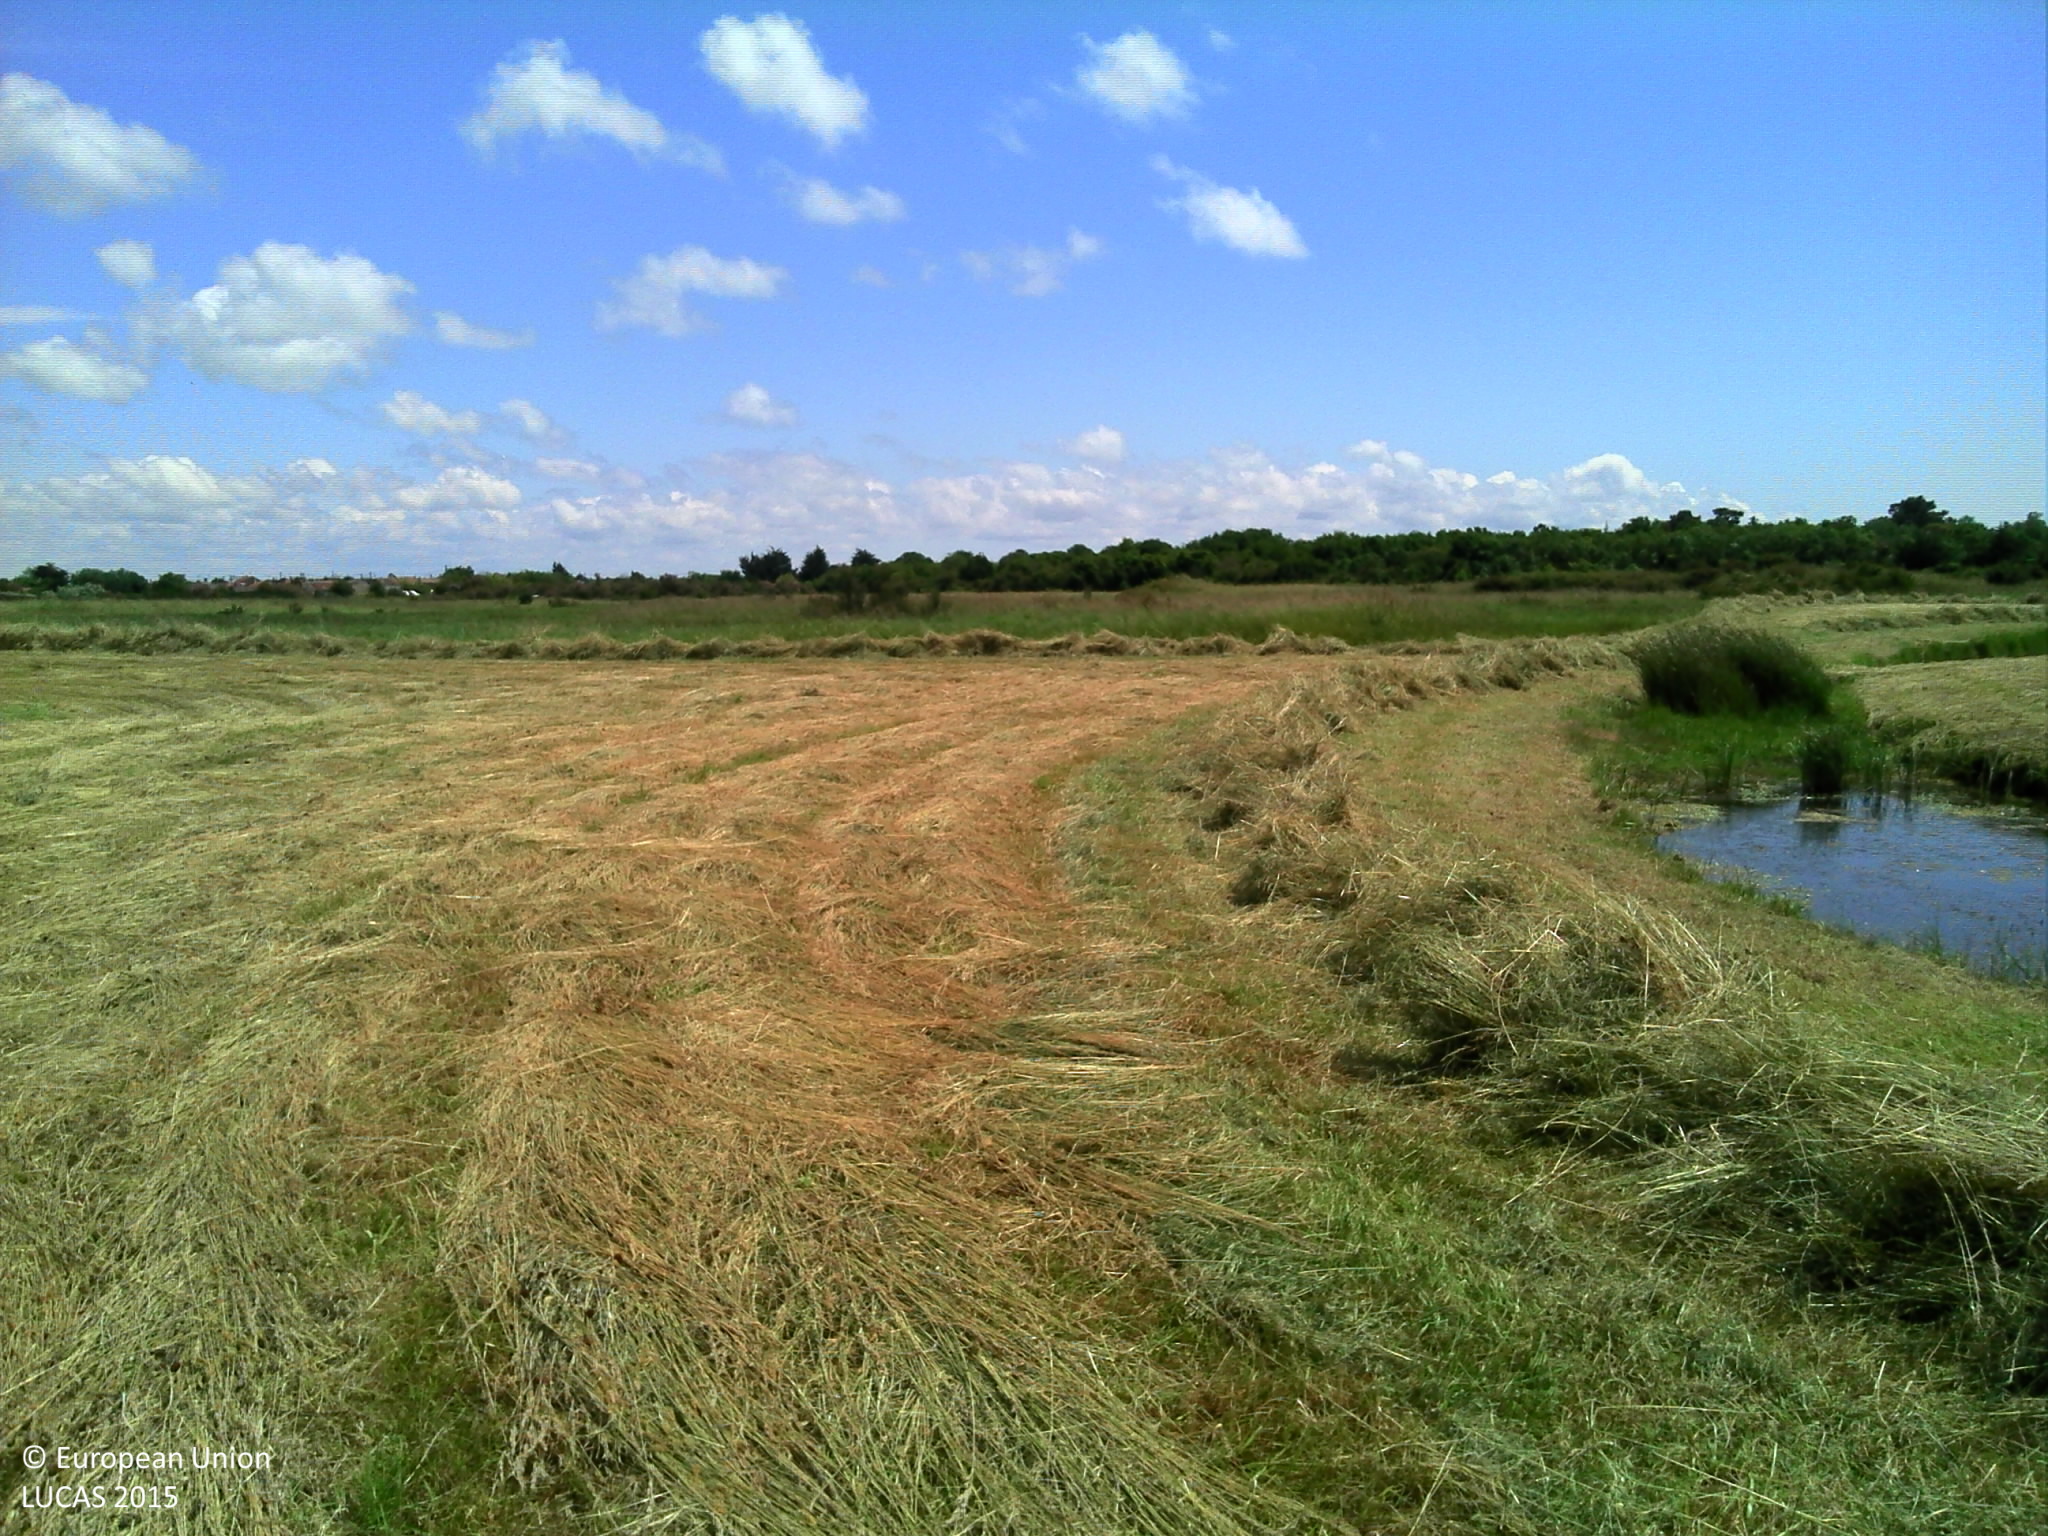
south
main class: Grassland
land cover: Grassland without tree/shrub cover
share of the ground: > 75 %
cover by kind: herbaceous plants 100 %
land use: Agriculture (excluding fallow land and kitchen gardens)
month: May
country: FR
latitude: 45.9358
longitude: -1.2657
